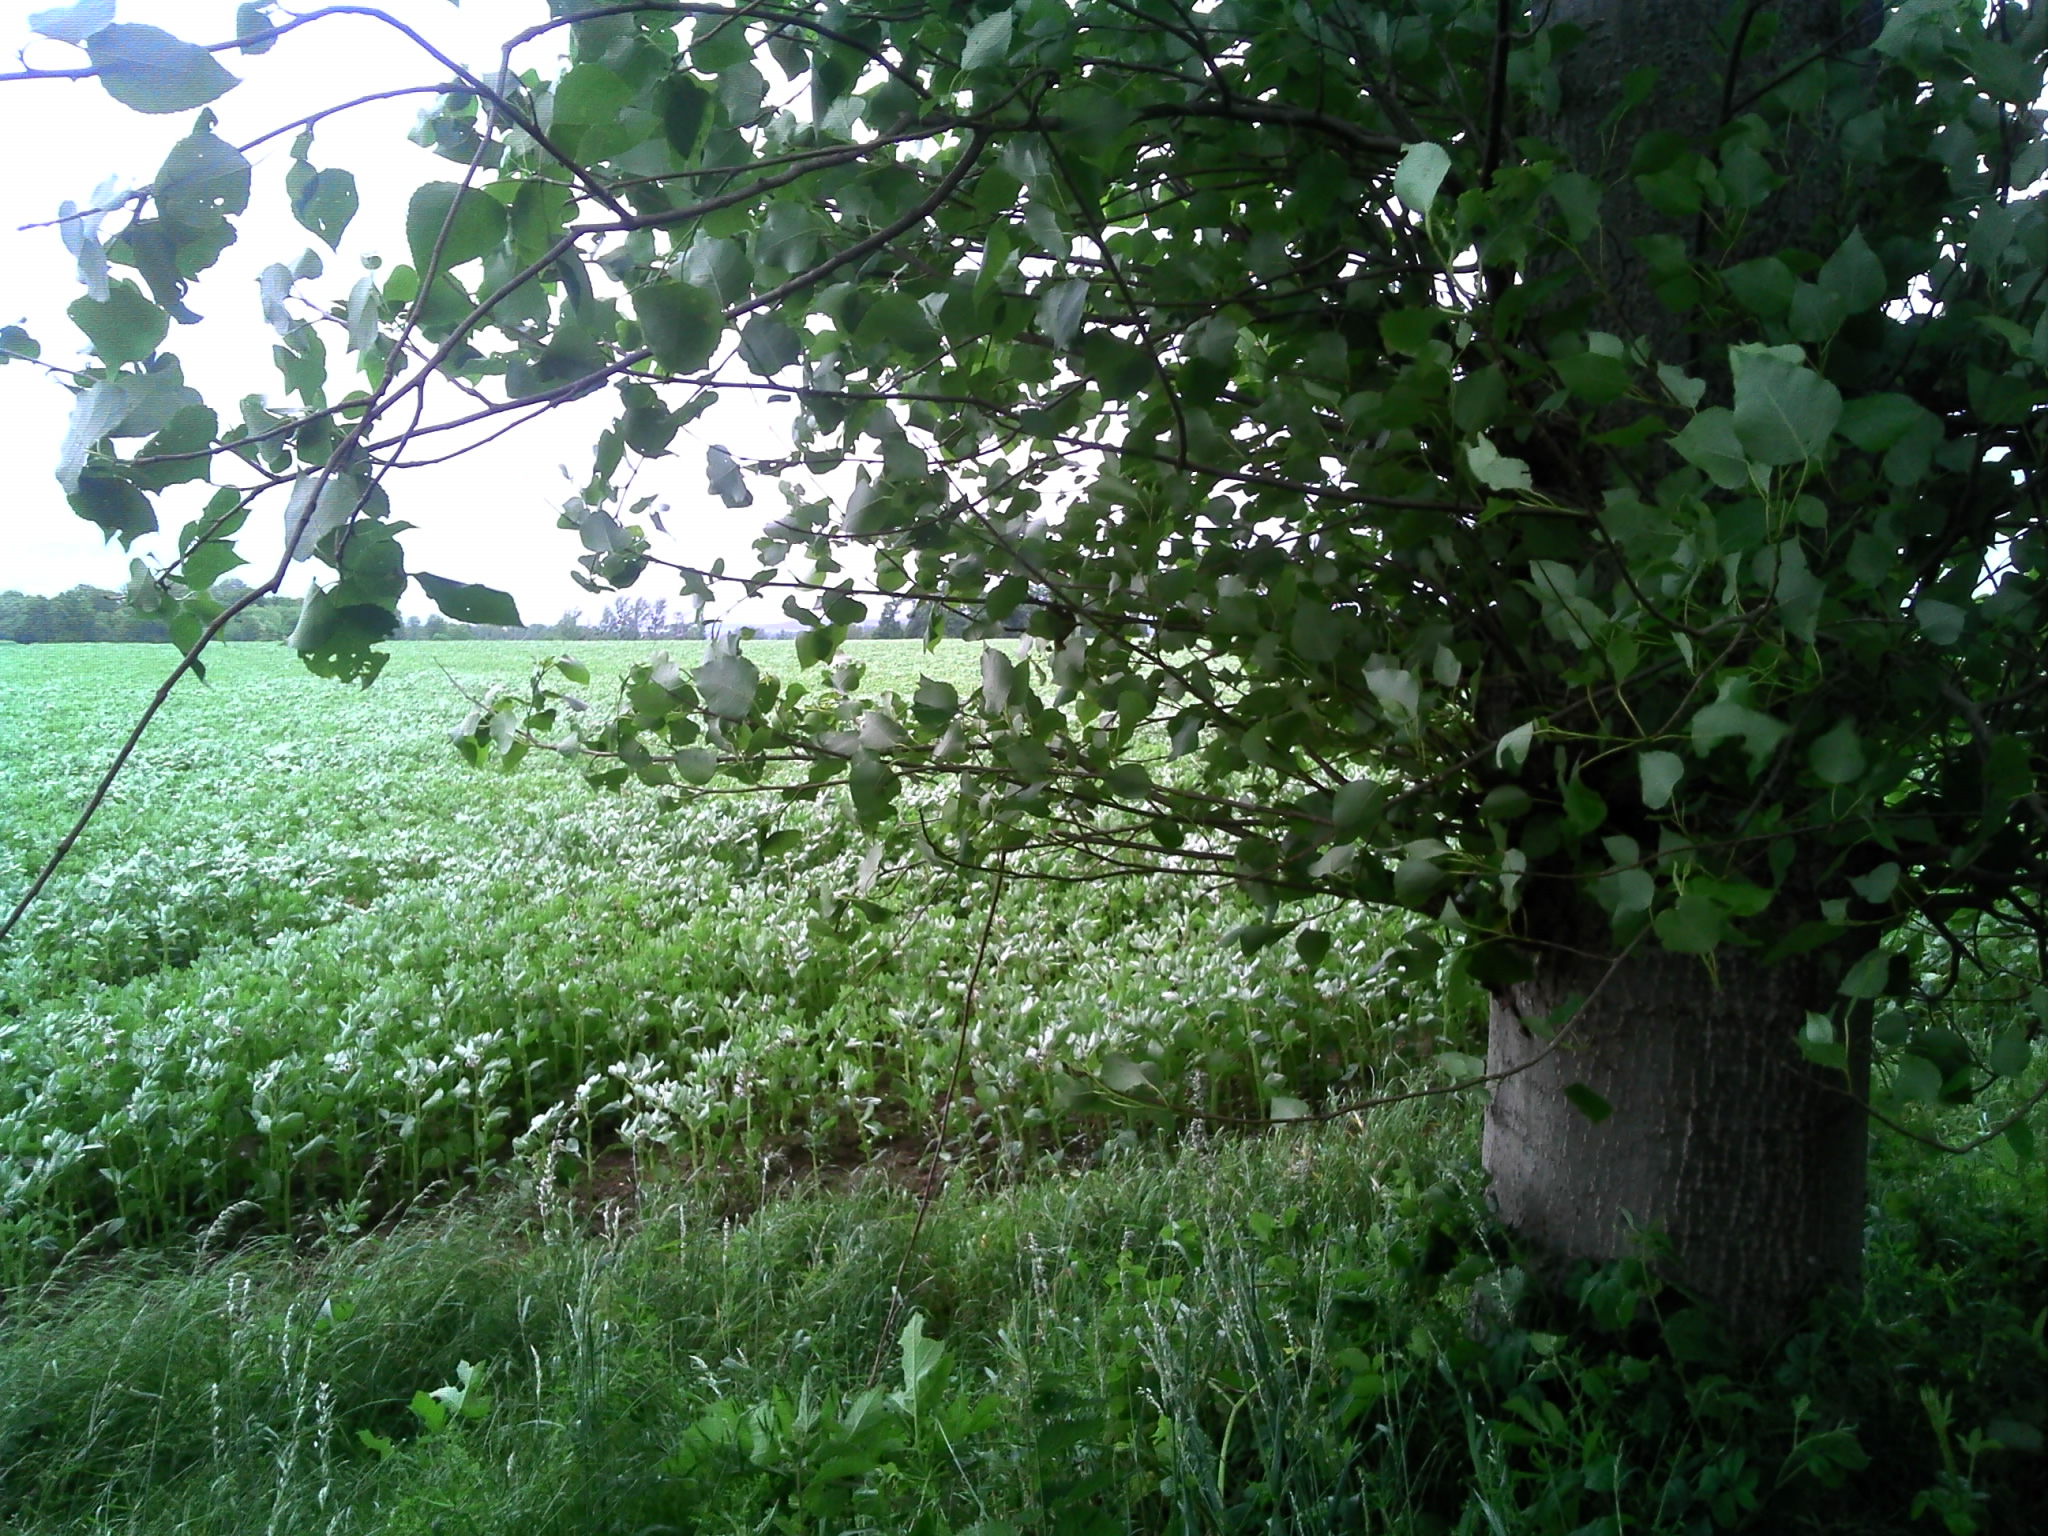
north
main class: Woodland
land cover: Broadleaved woodland
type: exotic forest
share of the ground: > 75 %
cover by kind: broadleaved forest trees 90 %, shrubs 10 %
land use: Forestry
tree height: > 5 m
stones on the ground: < 10 %
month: June
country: FR
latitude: 49.5858
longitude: 3.2276
